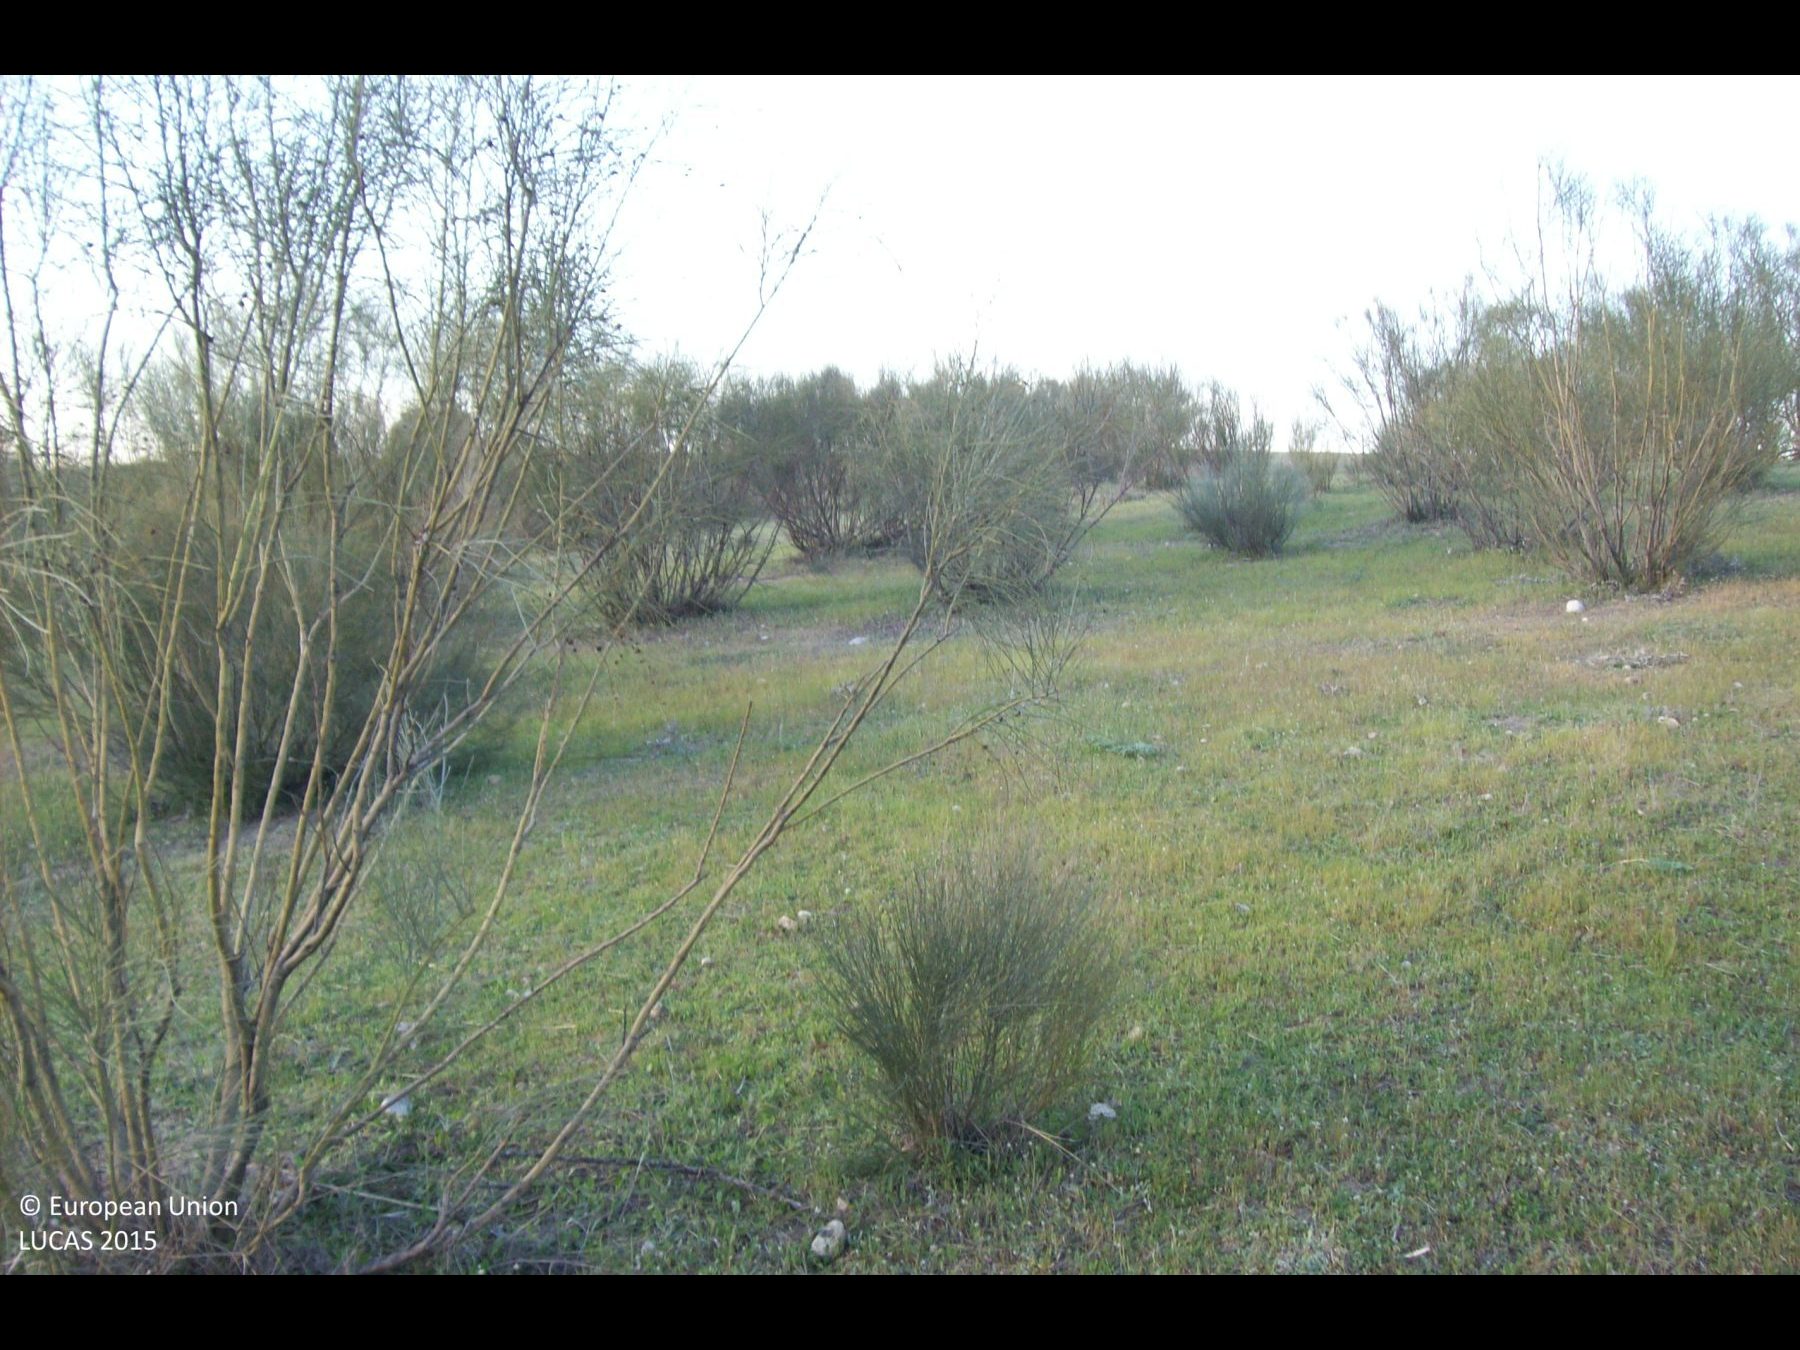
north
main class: Shrubland
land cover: Shrubland without tree cover
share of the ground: 10 - 25 %
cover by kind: herbaceous plants 90 %, shrubs 10 %
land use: Semi-natural and natural areas not in use
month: April
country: ES
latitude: 40.3896
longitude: -3.9056
